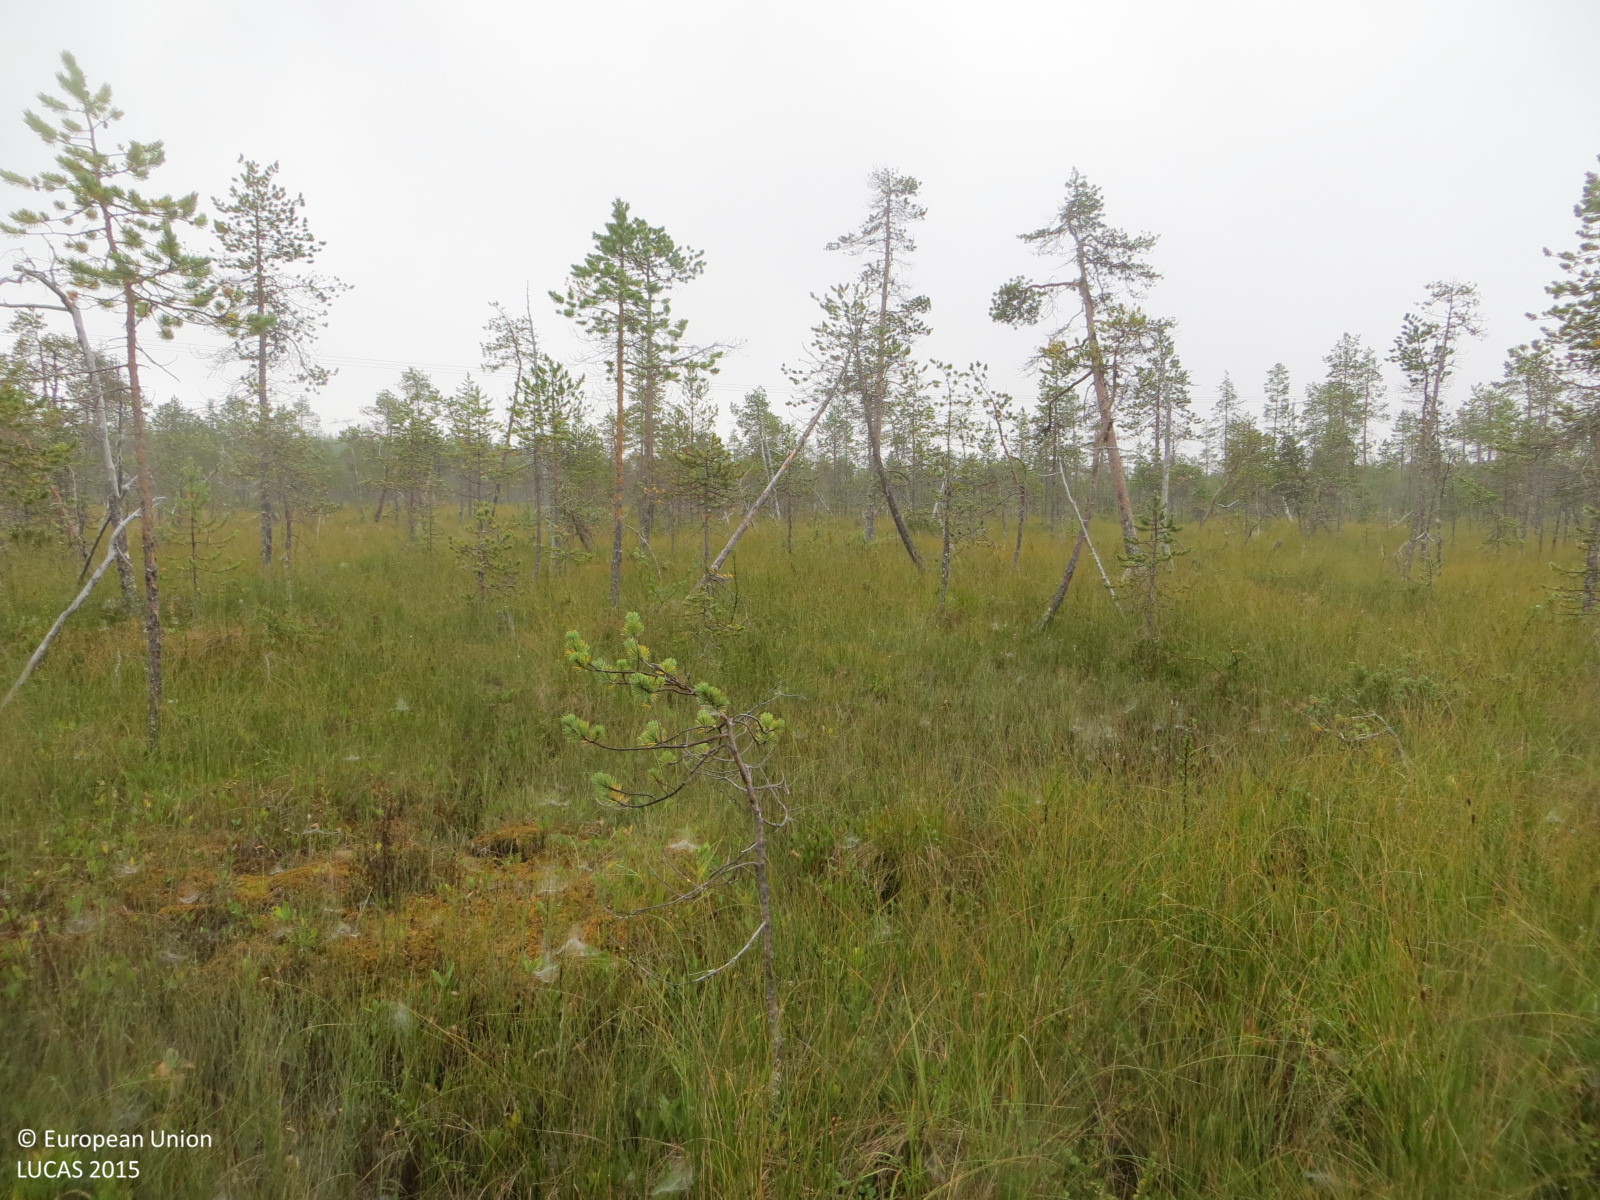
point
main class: Woodland
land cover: Pine dominated coniferous woodland
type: mire and swamp forests
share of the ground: 10 - 25 %
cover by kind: herbaceous plants 70 %, coniferous forest trees 15 %, shrubs 15 %
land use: Semi-natural and natural areas not in use
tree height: > 5 m
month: August
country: FI
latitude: 67.3712
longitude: 23.9752
